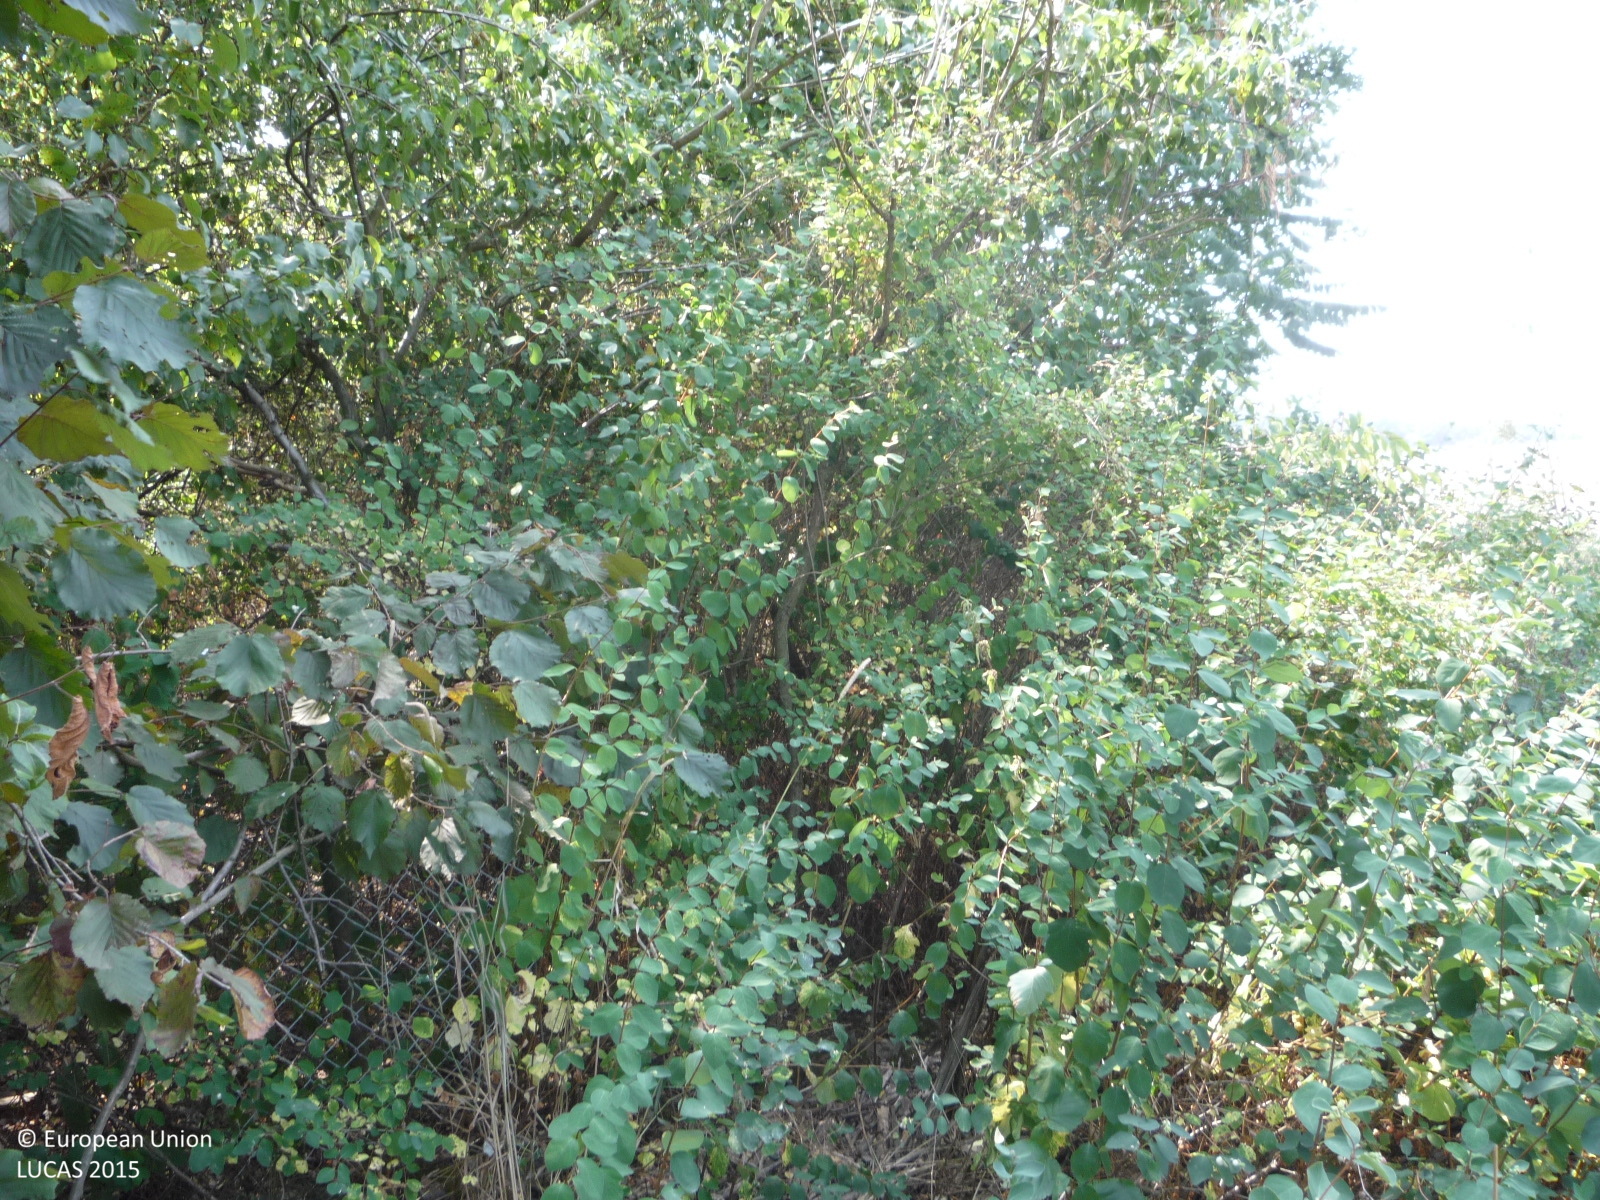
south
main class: Shrubland
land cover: Shrubland without tree cover
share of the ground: > 75 %
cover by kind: shrubs 50 %, herbaceous plants 50 %
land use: Semi-natural and natural areas not in use
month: August
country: CZ
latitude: 49.8582
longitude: 14.5782
